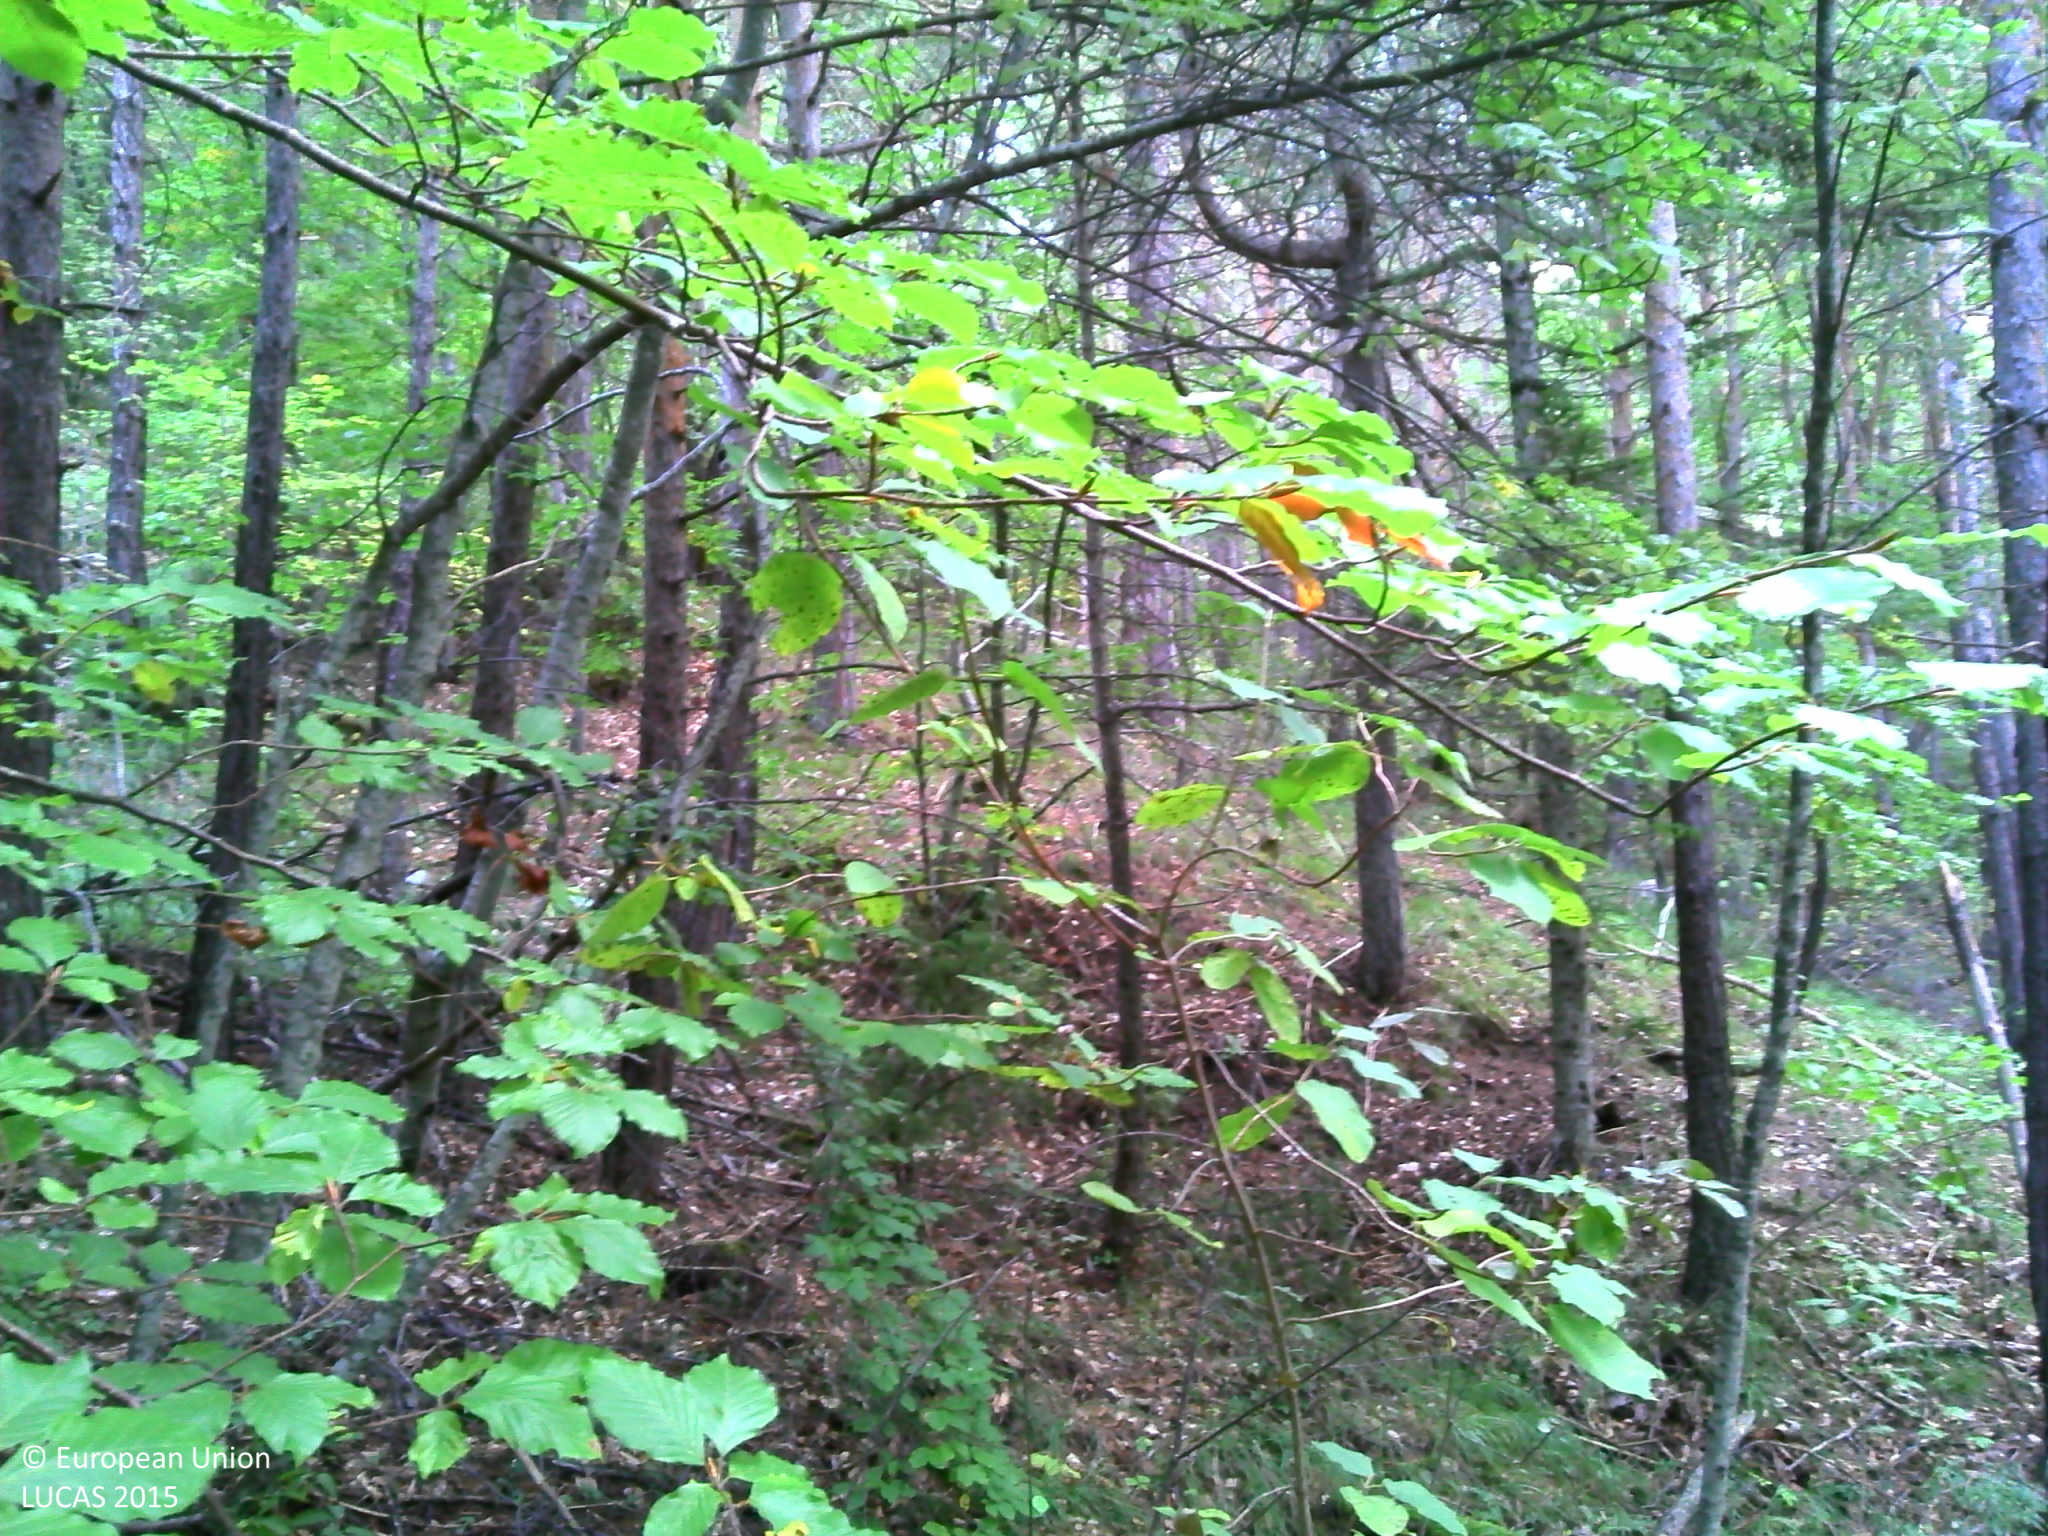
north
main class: Woodland
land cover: Pine dominated mixed woodland
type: alpine coniferous forest
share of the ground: > 75 %
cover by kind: coniferous forest trees 55 %, broadleaved forest trees 35 %, herbaceous plants 5 %, consolidated bare surface 5 %
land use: Forestry
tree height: > 5 m
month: September
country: FR
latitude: 44.5173
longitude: 6.2450
